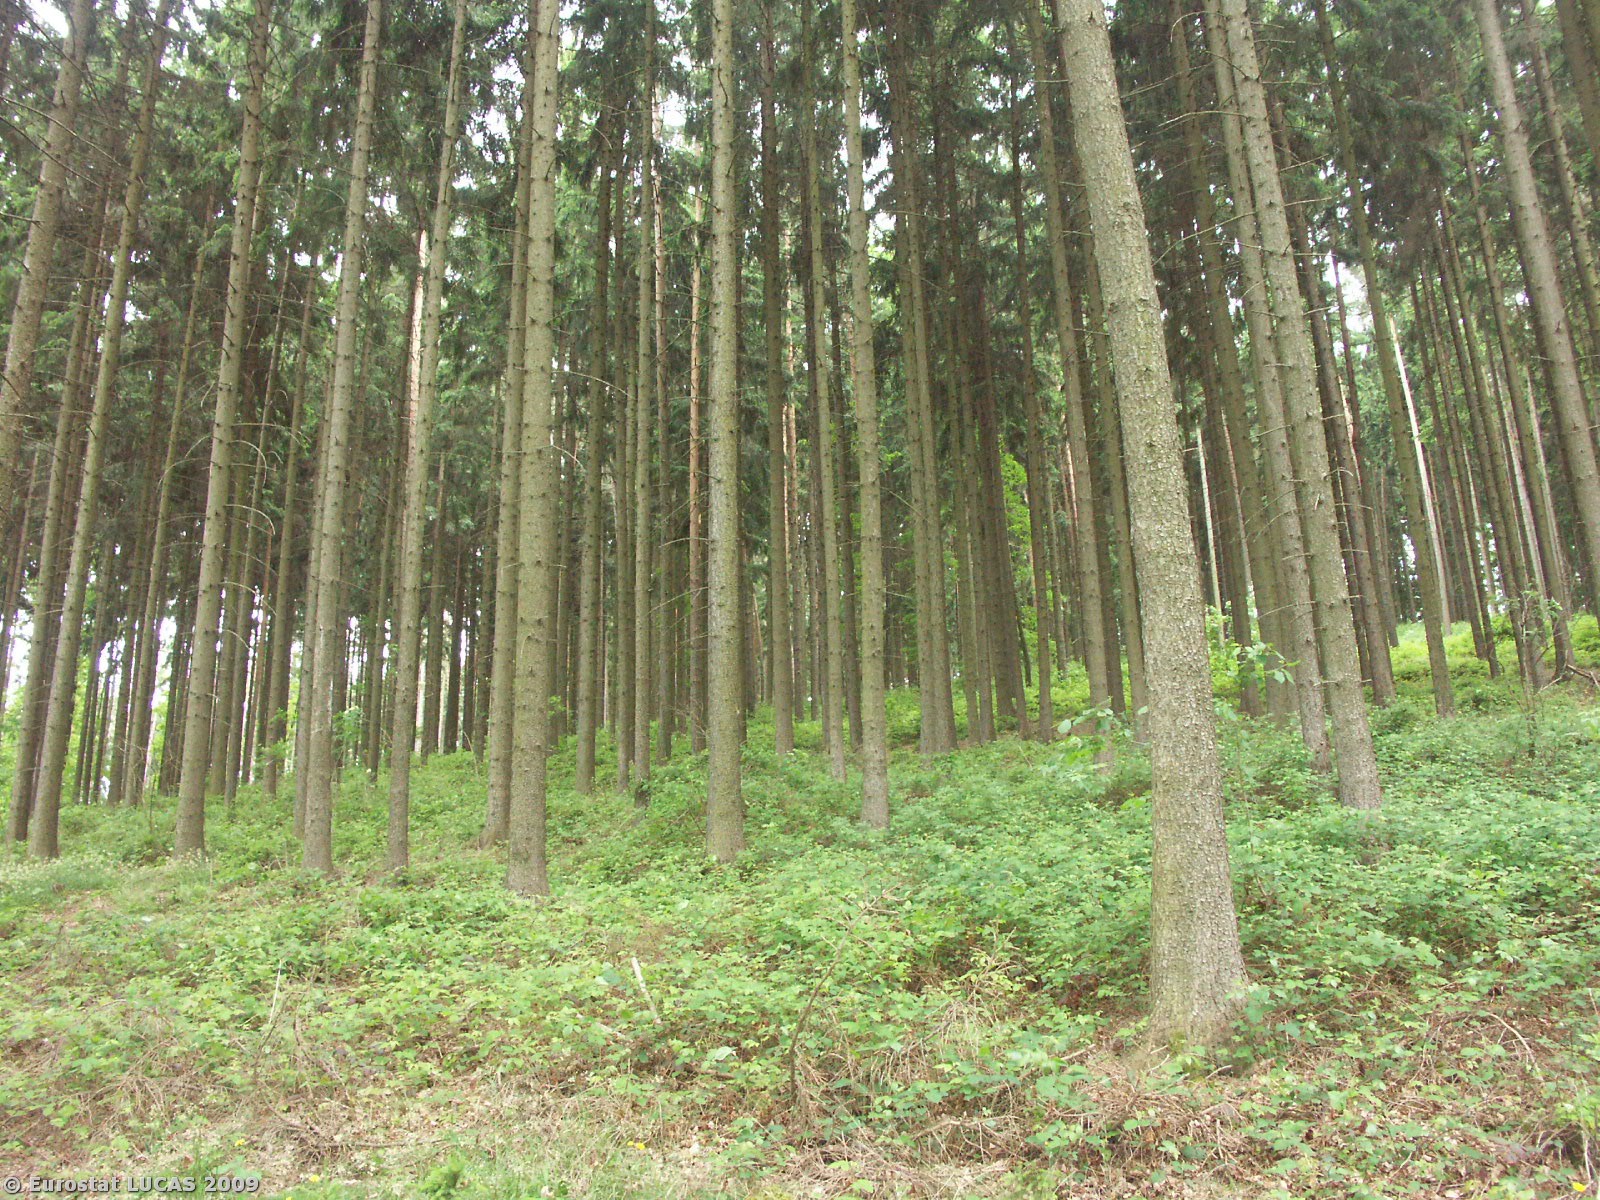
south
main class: Woodland
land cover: Mixed woodland
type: hemiboreal forest and nemoral coniferous forest and mixed broadleaved-coniferous forest
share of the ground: > 75 %
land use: Forestry
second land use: Nature reserves
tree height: > 5 m
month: May
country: CZ
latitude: 48.9145
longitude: 14.2991
